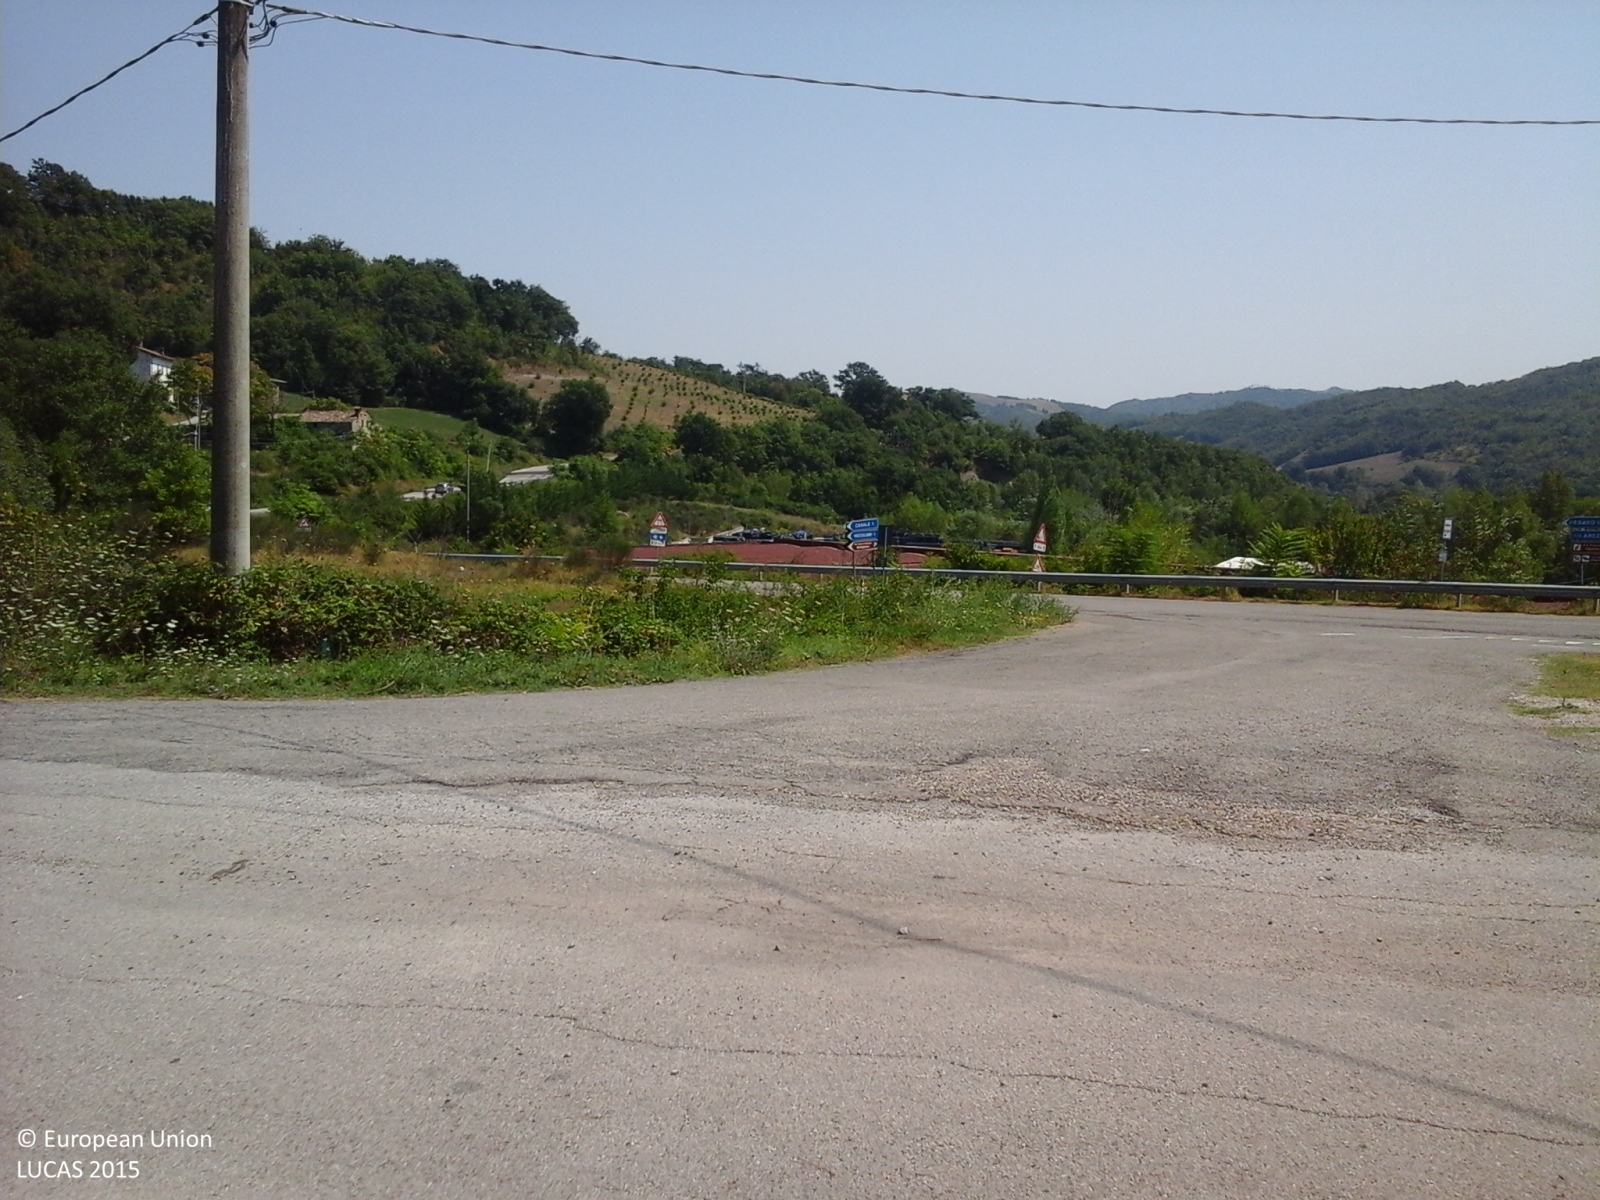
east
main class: Grassland
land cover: Grassland without tree/shrub cover
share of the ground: > 75 %
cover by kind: herbaceous plants 100 %
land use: Agriculture (excluding fallow land and kitchen gardens)
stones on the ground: < 10 %
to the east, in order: Grassland without tree/shrub cover; Grass margins; Paved roads, cycling and walking lanes; Electric lines; Grass margins; Grassland without tree/shrub cover; Grass margins; Paved roads, cycling and walking lanes; Shrubland without tree cover; Artificial constructions in urban areas
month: August
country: IT
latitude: 43.7106
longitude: 12.3397
